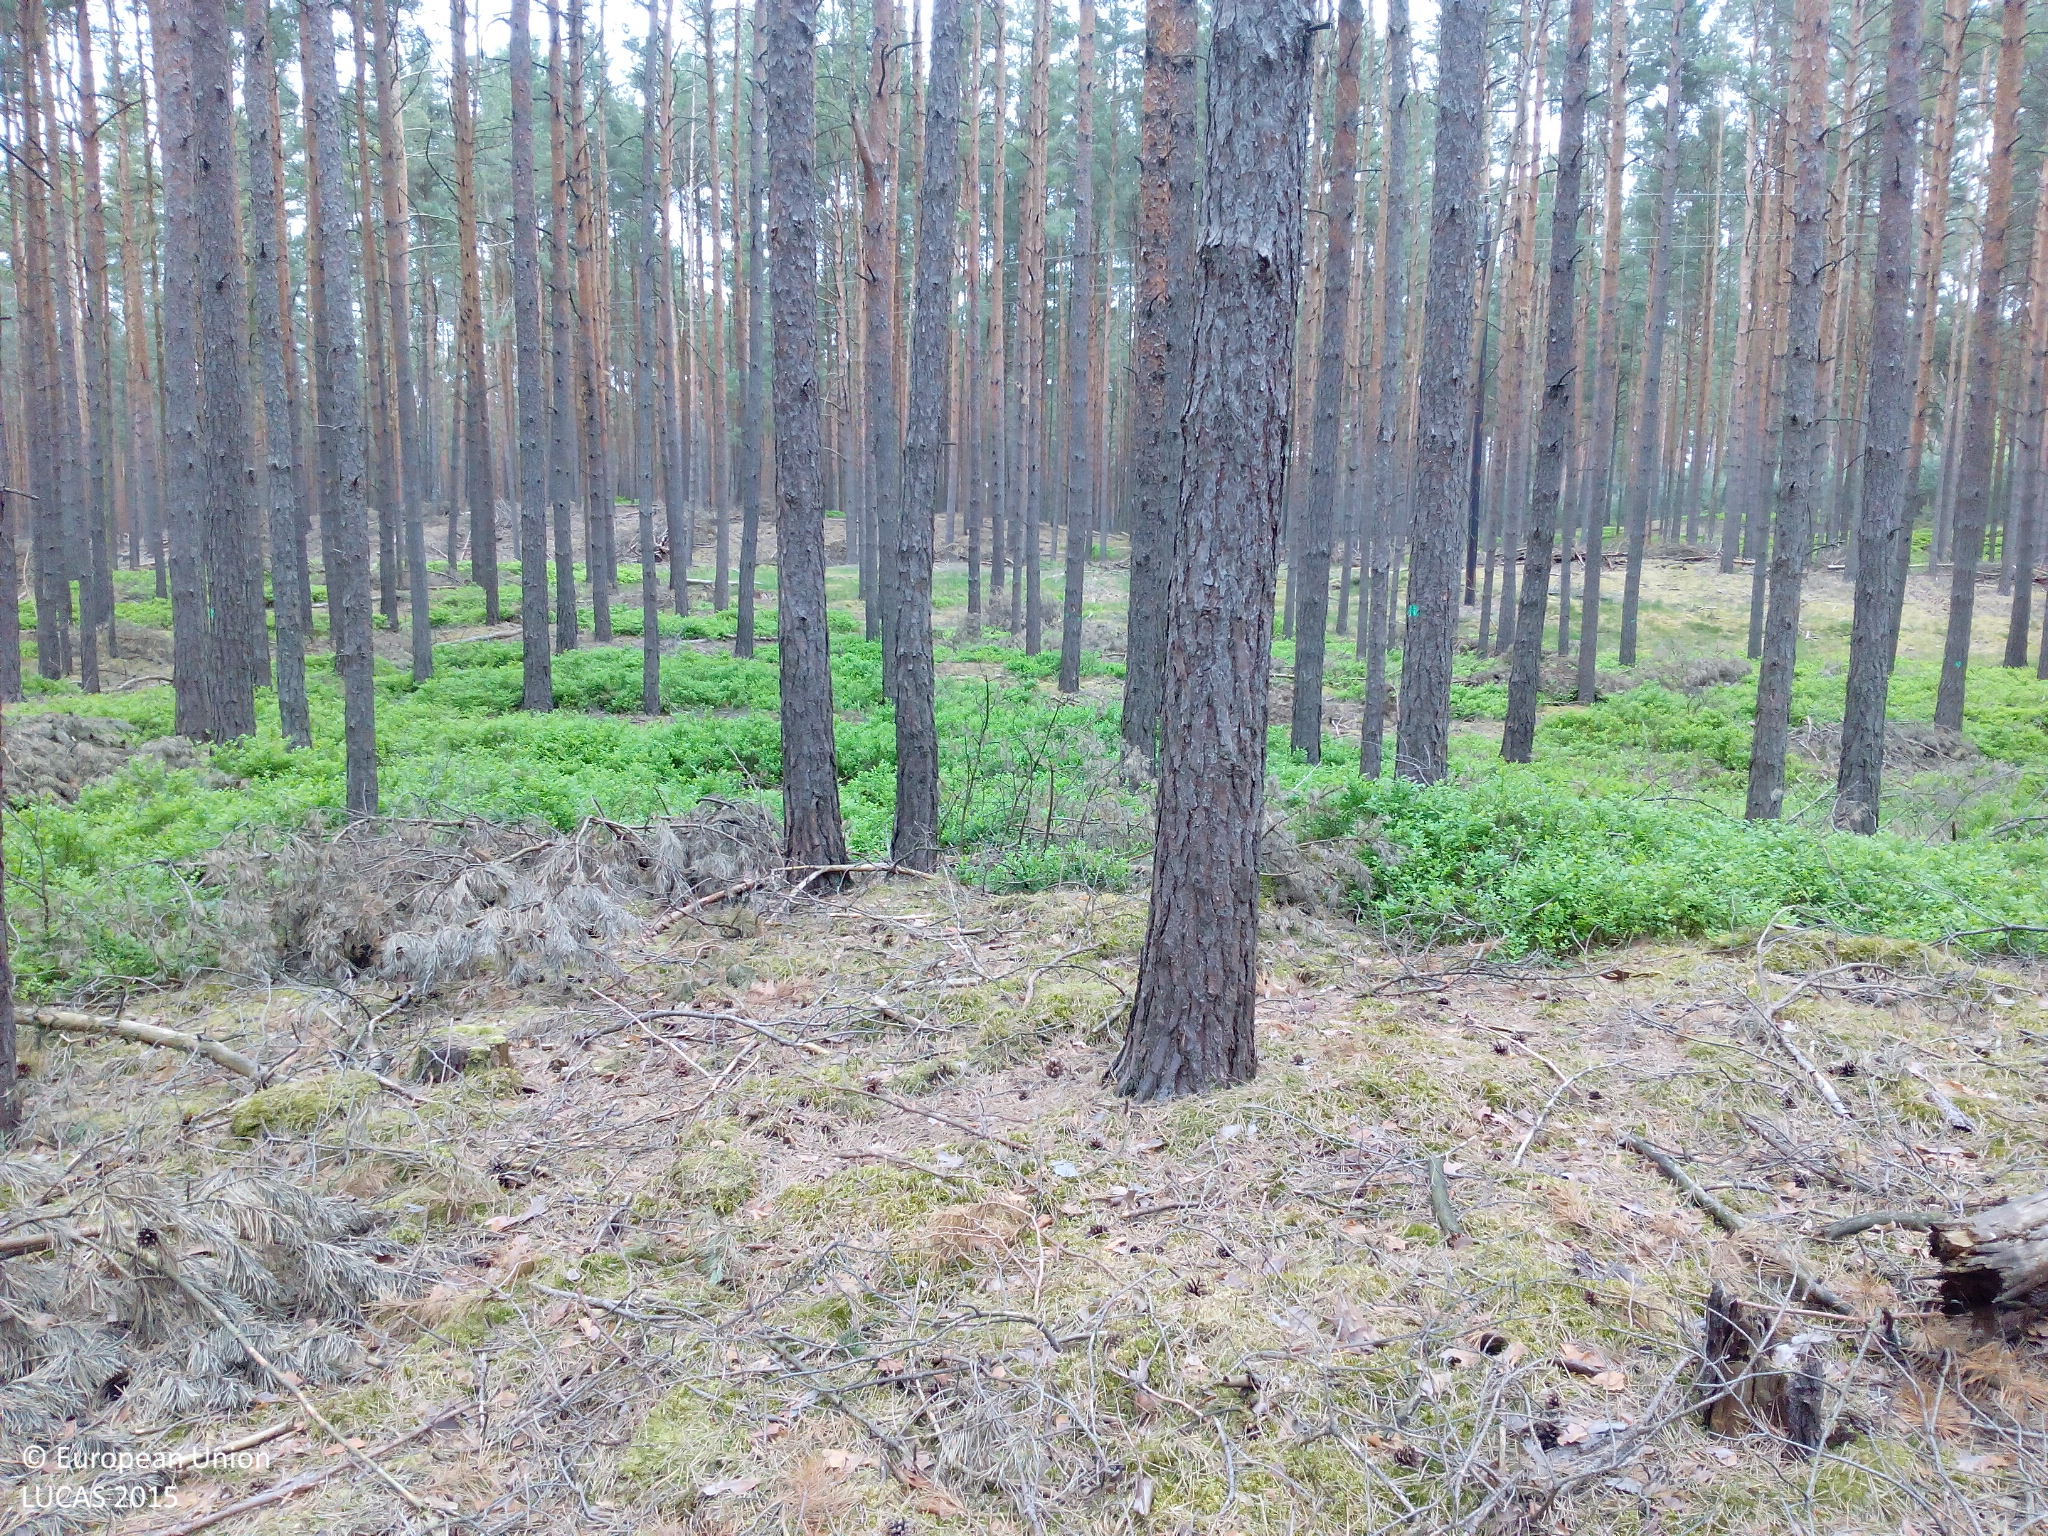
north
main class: Woodland
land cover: Pine dominated coniferous woodland
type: hemiboreal forest and nemoral coniferous forest and mixed broadleaved-coniferous forest
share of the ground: 25 - 50 %
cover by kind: coniferous forest trees 45 %, lichens and mosses 30 %, herbaceous plants 25 %
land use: Forestry
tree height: > 5 m
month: May
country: DE
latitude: 52.9073
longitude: 11.5012
